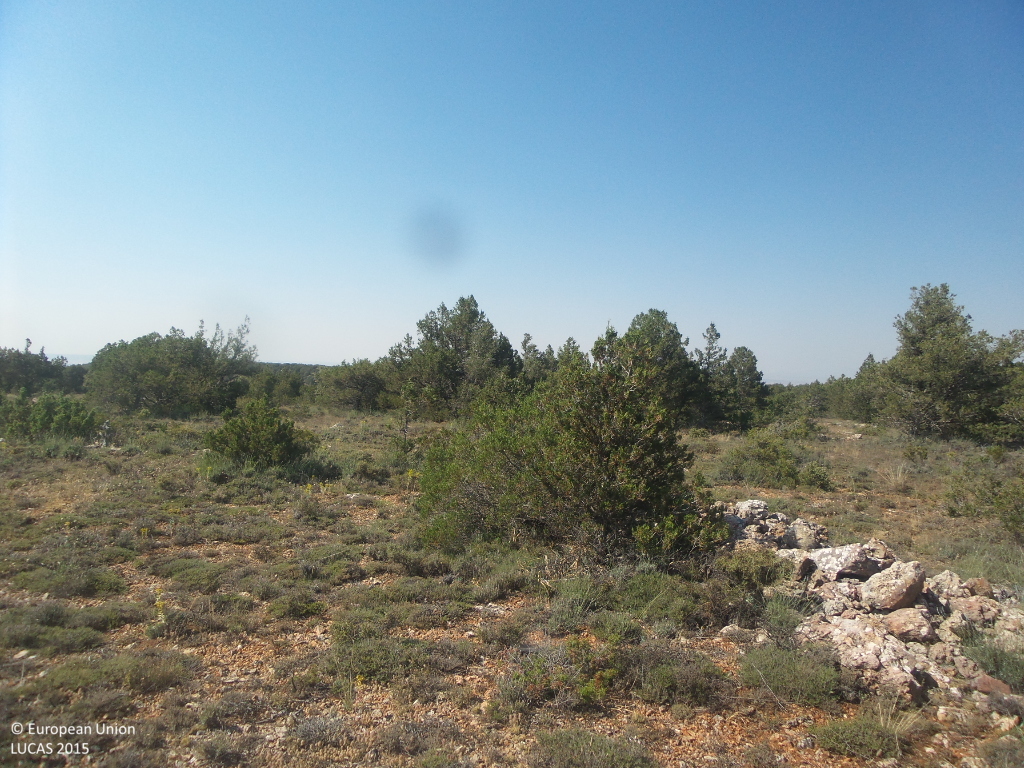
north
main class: Woodland
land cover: Other coniferous woodland
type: coniferous forest of the mediterranean region
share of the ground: 10 - 25 %
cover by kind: unconsolidated bare surface 45 %, shrubs 35 %, coniferous forest trees 15 %, herbaceous plants 5 %
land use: Semi-natural and natural areas not in use
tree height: < 5 m
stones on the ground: 25 - 50 %
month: July
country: ES
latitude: 41.1208
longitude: -2.1163
